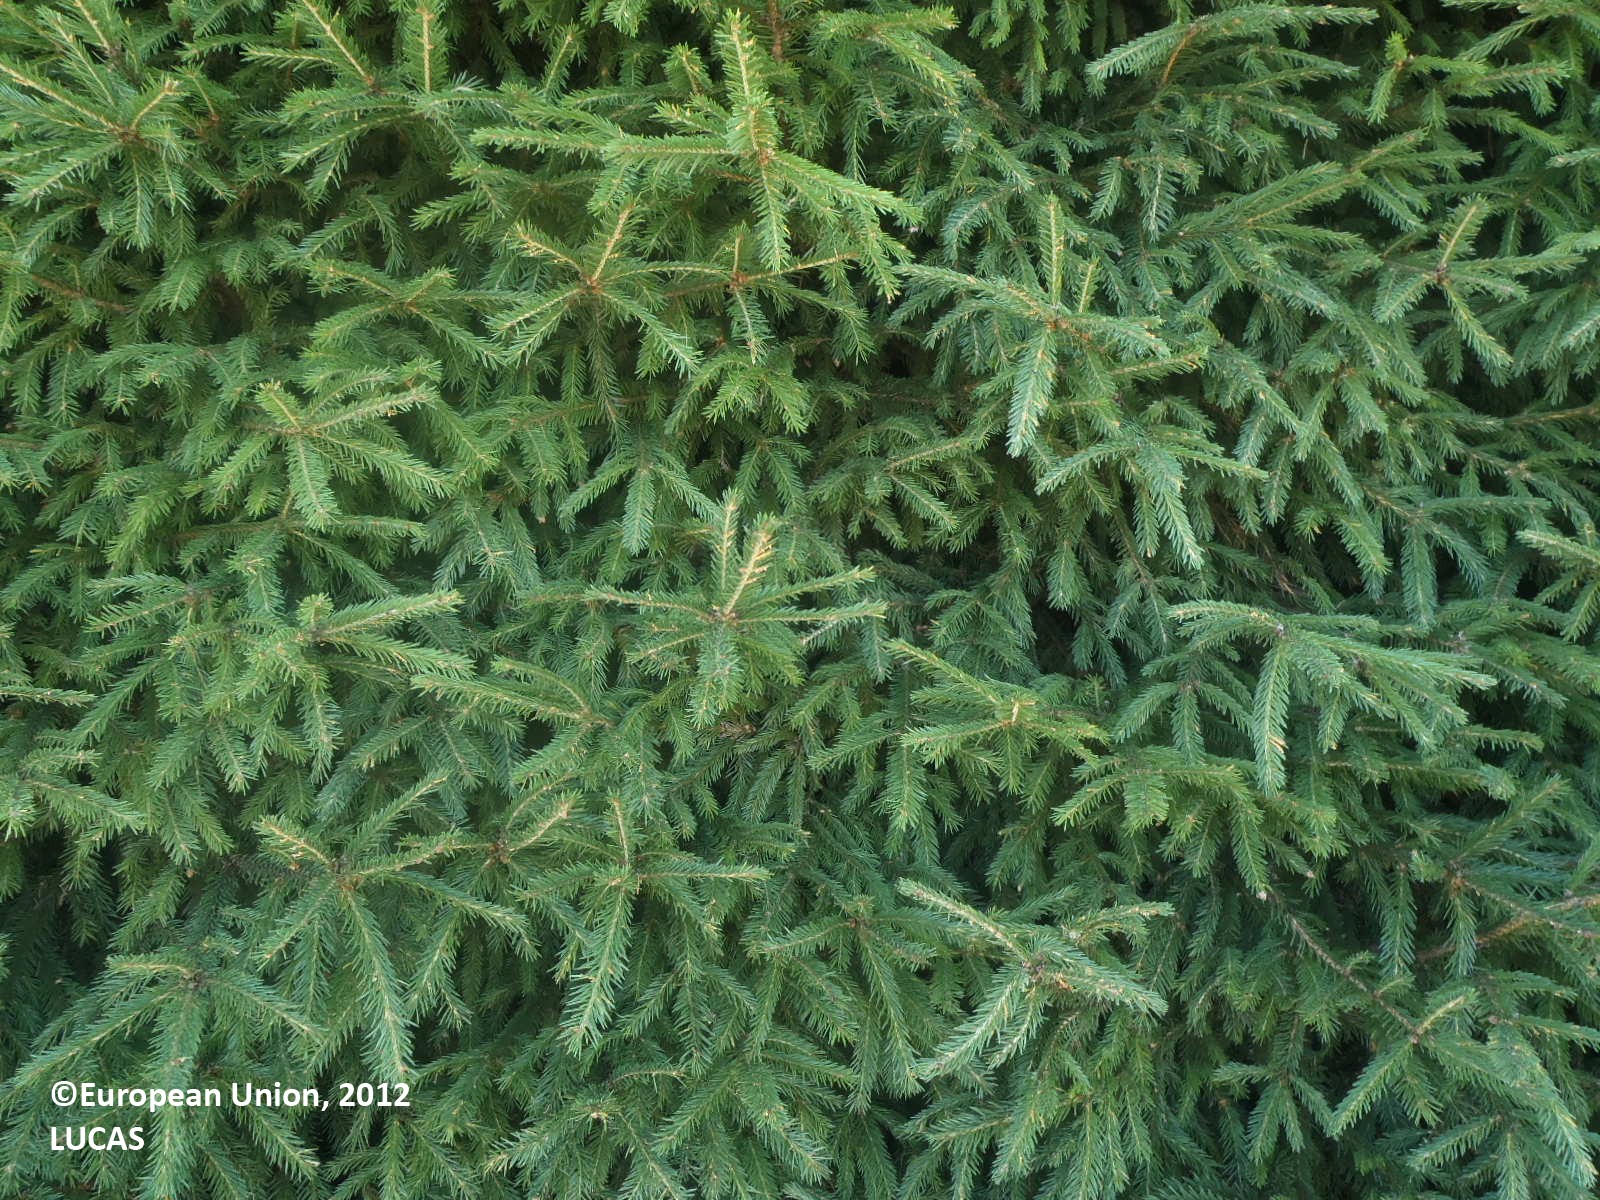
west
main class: Woodland
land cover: Spruce dominated coniferous woodland
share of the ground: > 75 %
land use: Residential
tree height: < 5 m
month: July
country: FI
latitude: 61.1940
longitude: 22.0593
